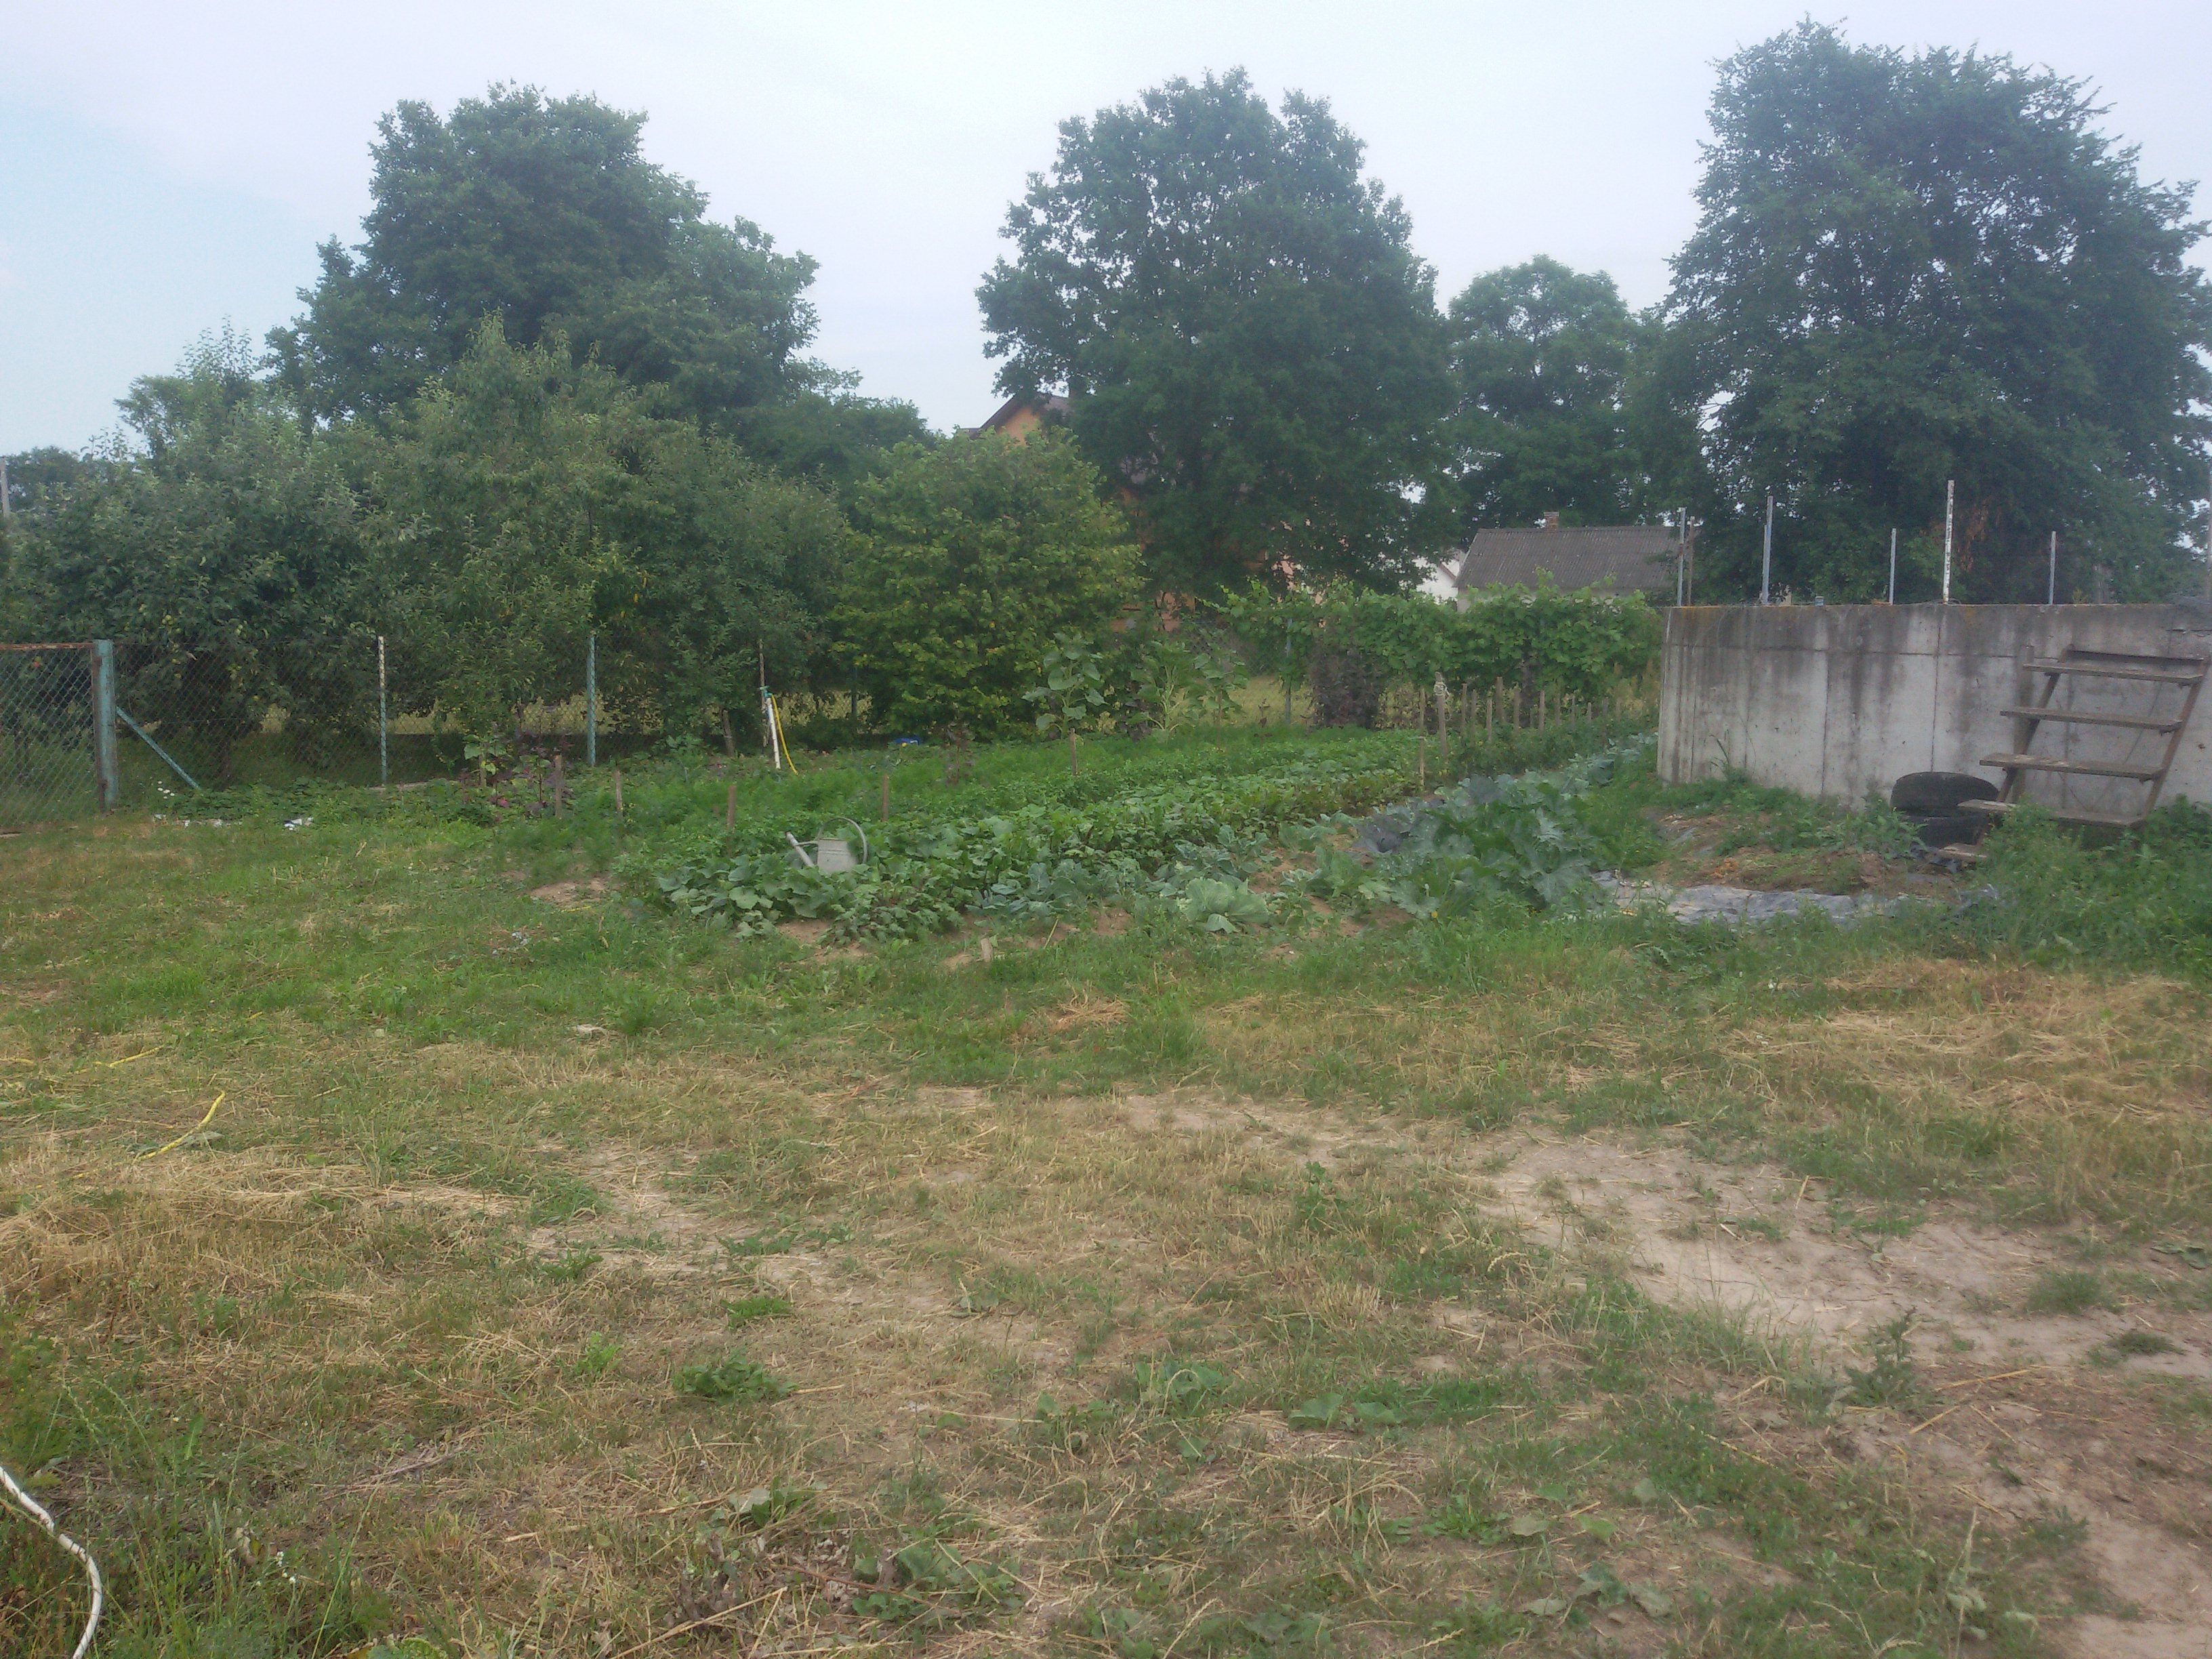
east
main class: Grassland
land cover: Spontaneously vegetated surfaces
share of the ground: 50 - 75 %
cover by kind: herbaceous plants 55 %, unconsolidated bare surface 45 %
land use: Agriculture (excluding fallow land and kitchen gardens)
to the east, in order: Spontaneously vegetated surfaces; Other fresh vegetables; Fences; Grassland without tree/shrub cover; Artificial constructions in urban areas
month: May
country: PL
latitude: 52.8349
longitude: 22.2187
